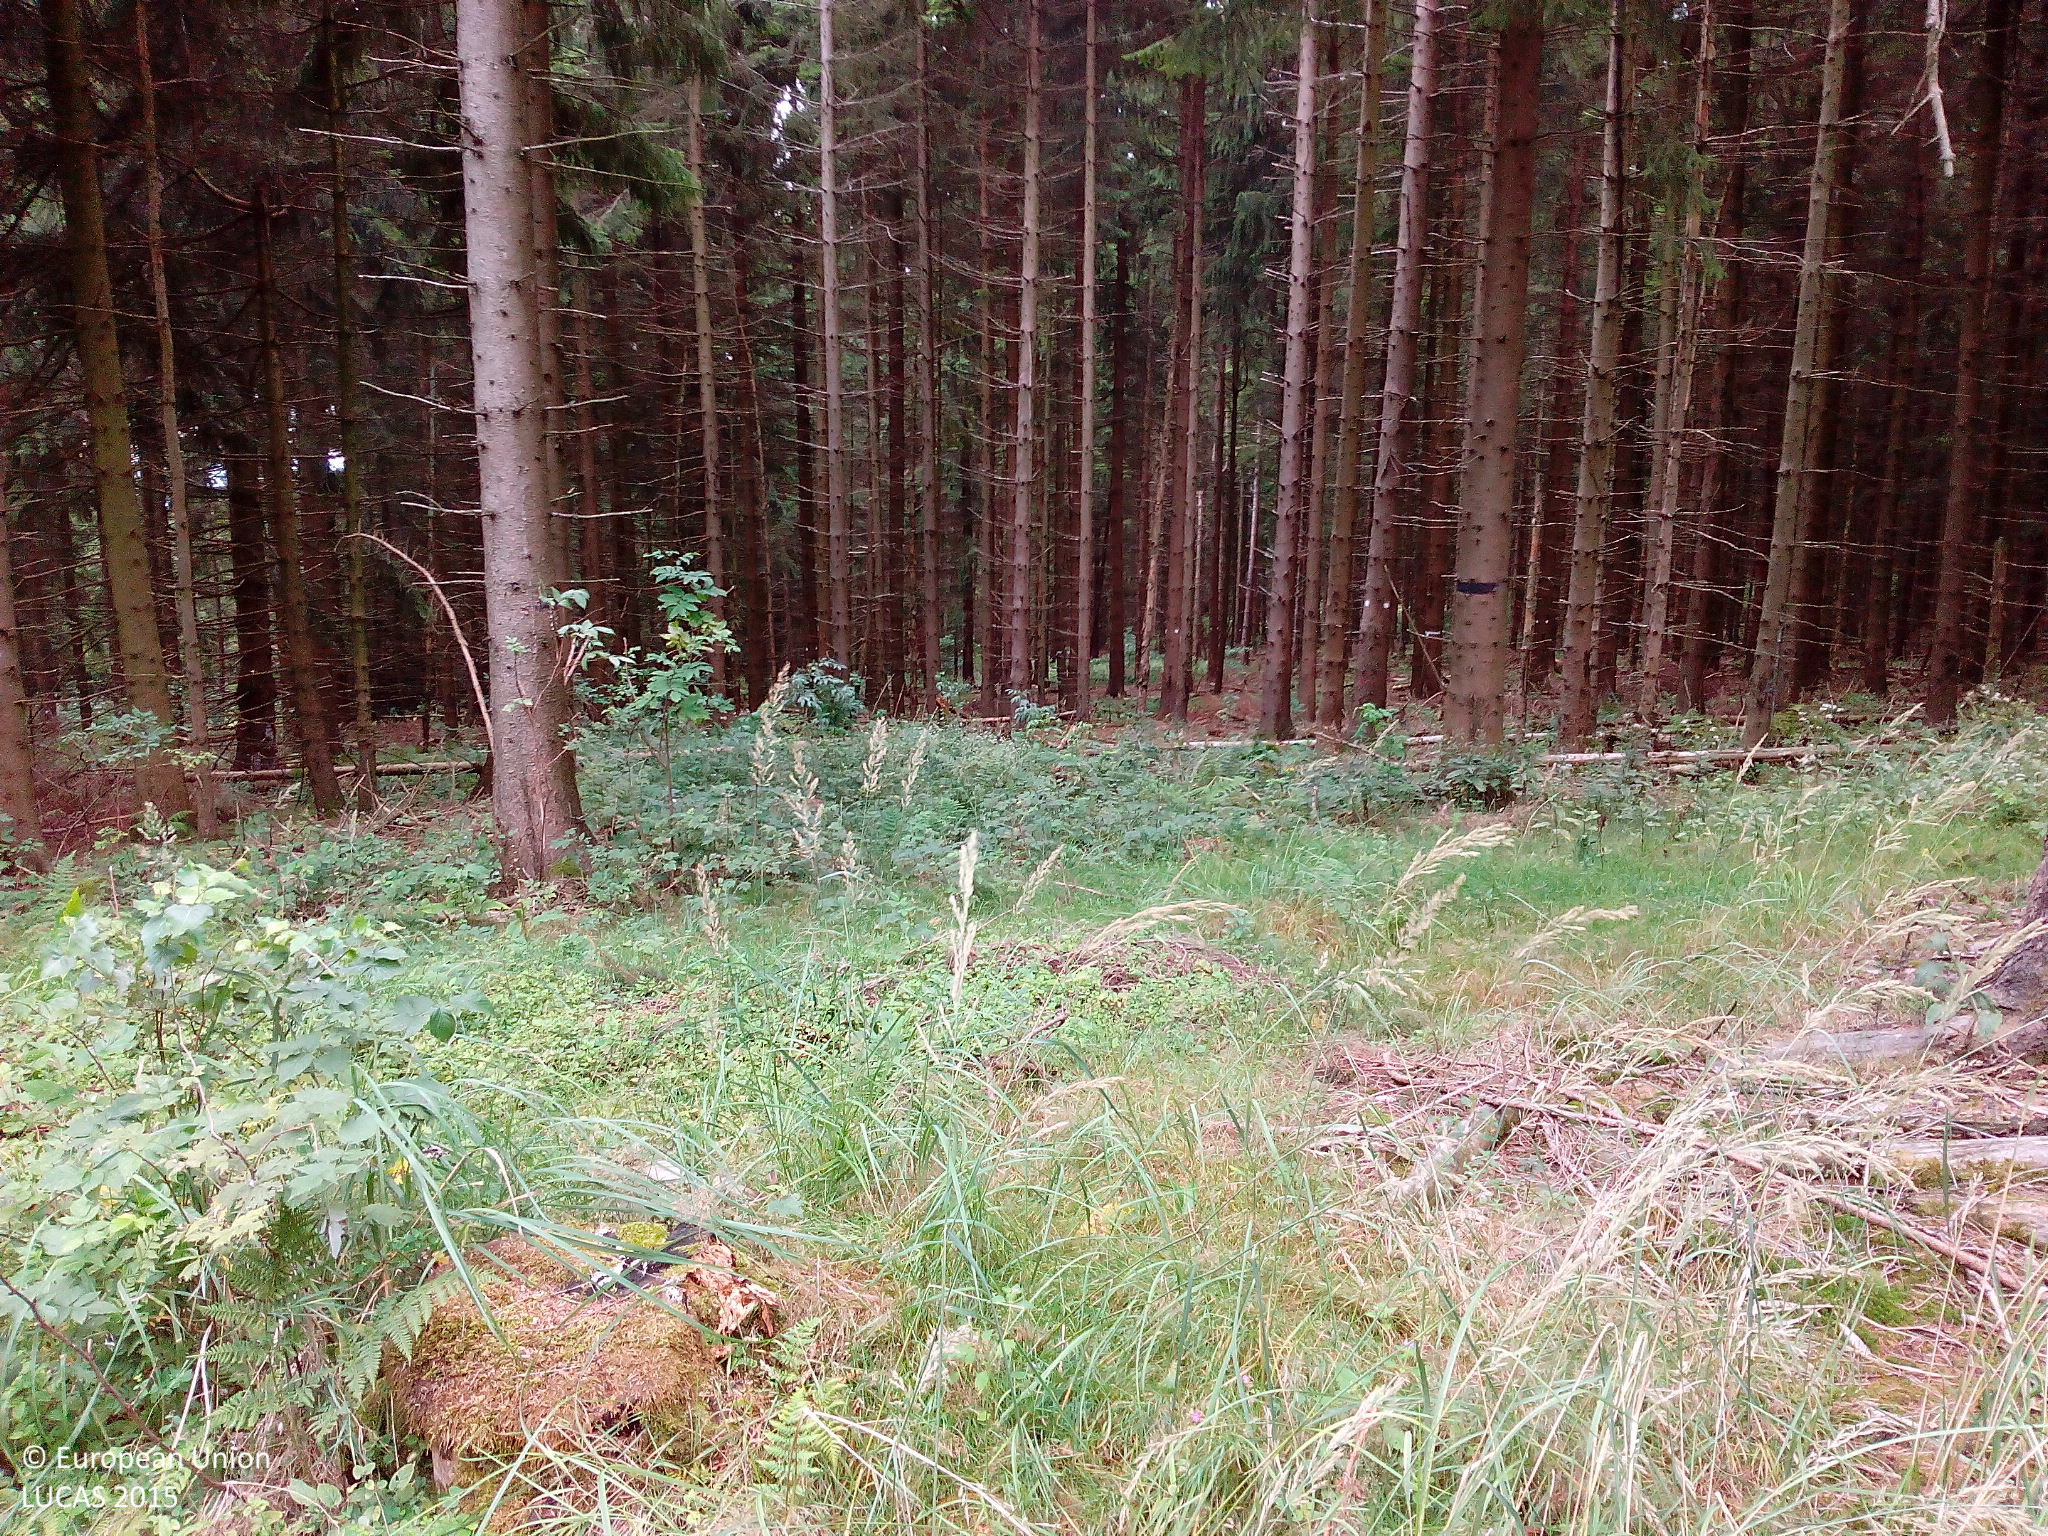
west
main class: Woodland
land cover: Spruce dominated coniferous woodland
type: hemiboreal forest and nemoral coniferous forest and mixed broadleaved-coniferous forest
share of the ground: 50 - 75 %
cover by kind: coniferous forest trees 50 %, herbaceous plants 40 %, shrubs 10 %
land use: Forestry
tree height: > 5 m
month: August
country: DE
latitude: 50.5408
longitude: 9.1677
